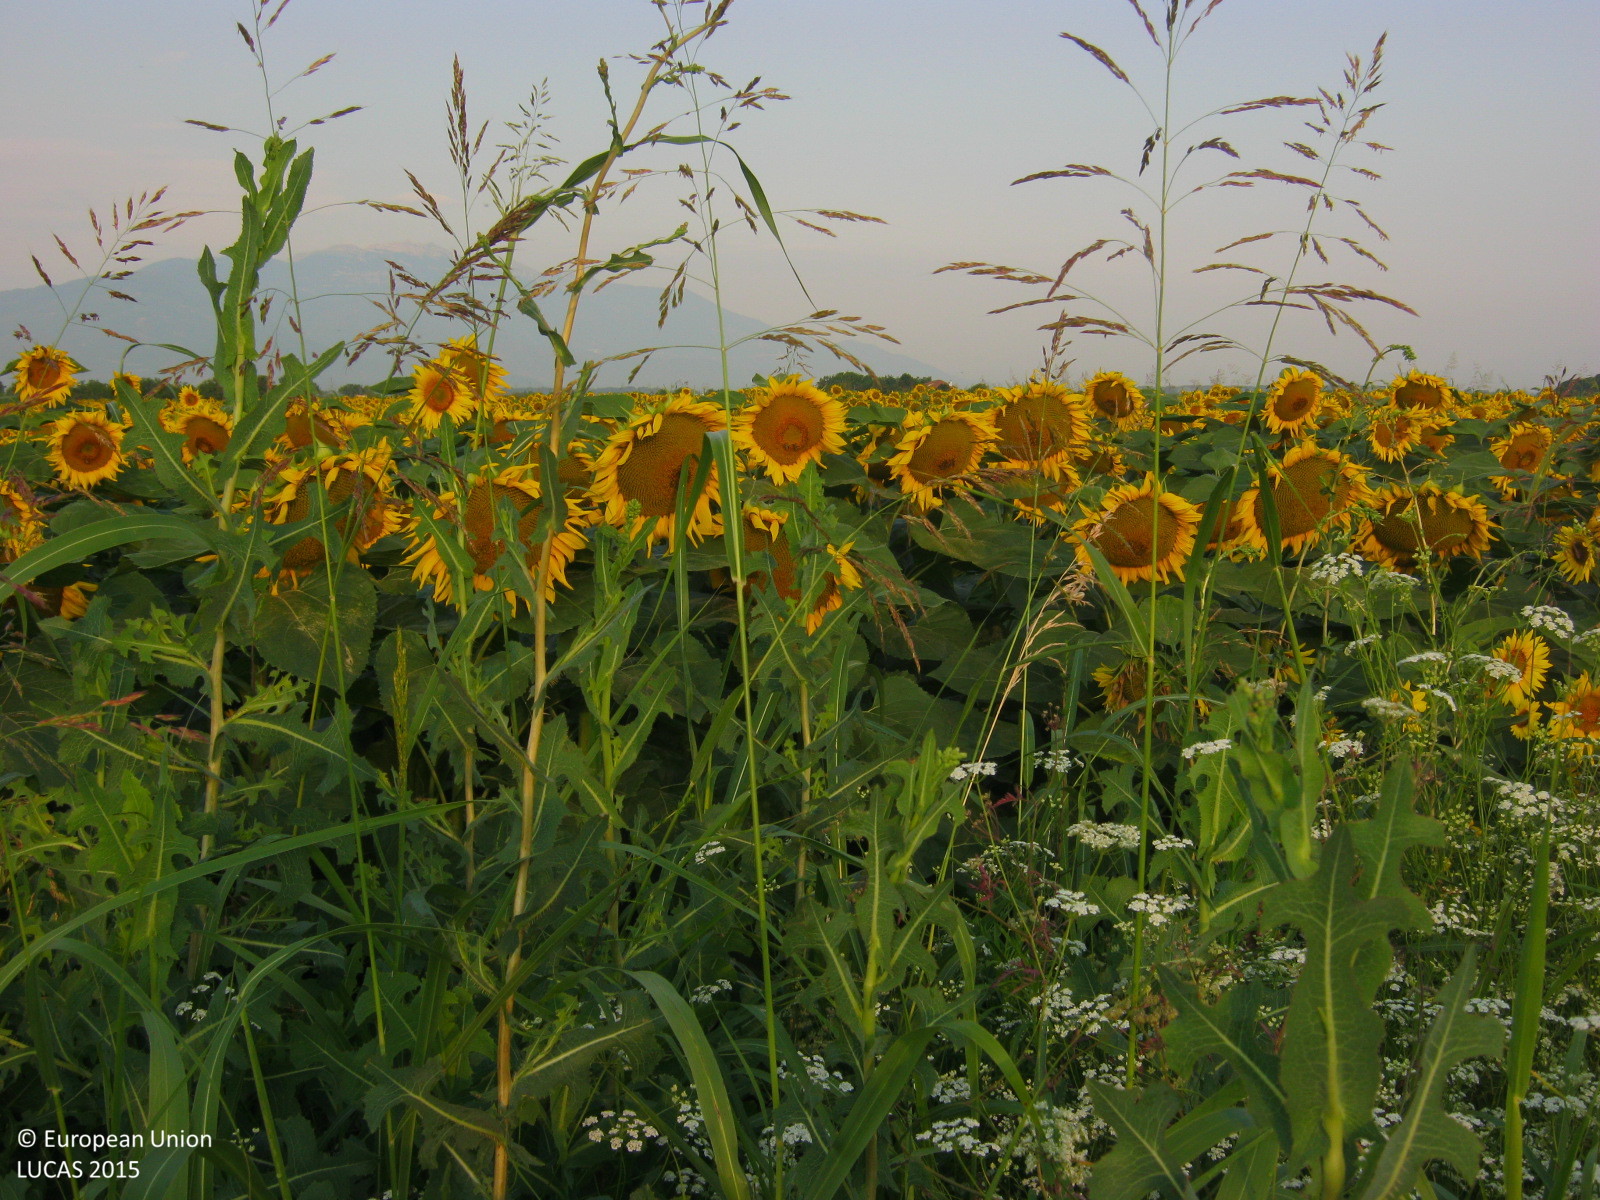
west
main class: Cropland
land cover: Sunflower
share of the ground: > 75 %
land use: Agriculture (excluding fallow land and kitchen gardens)
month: July
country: GR
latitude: 40.9845
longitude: 24.3529
